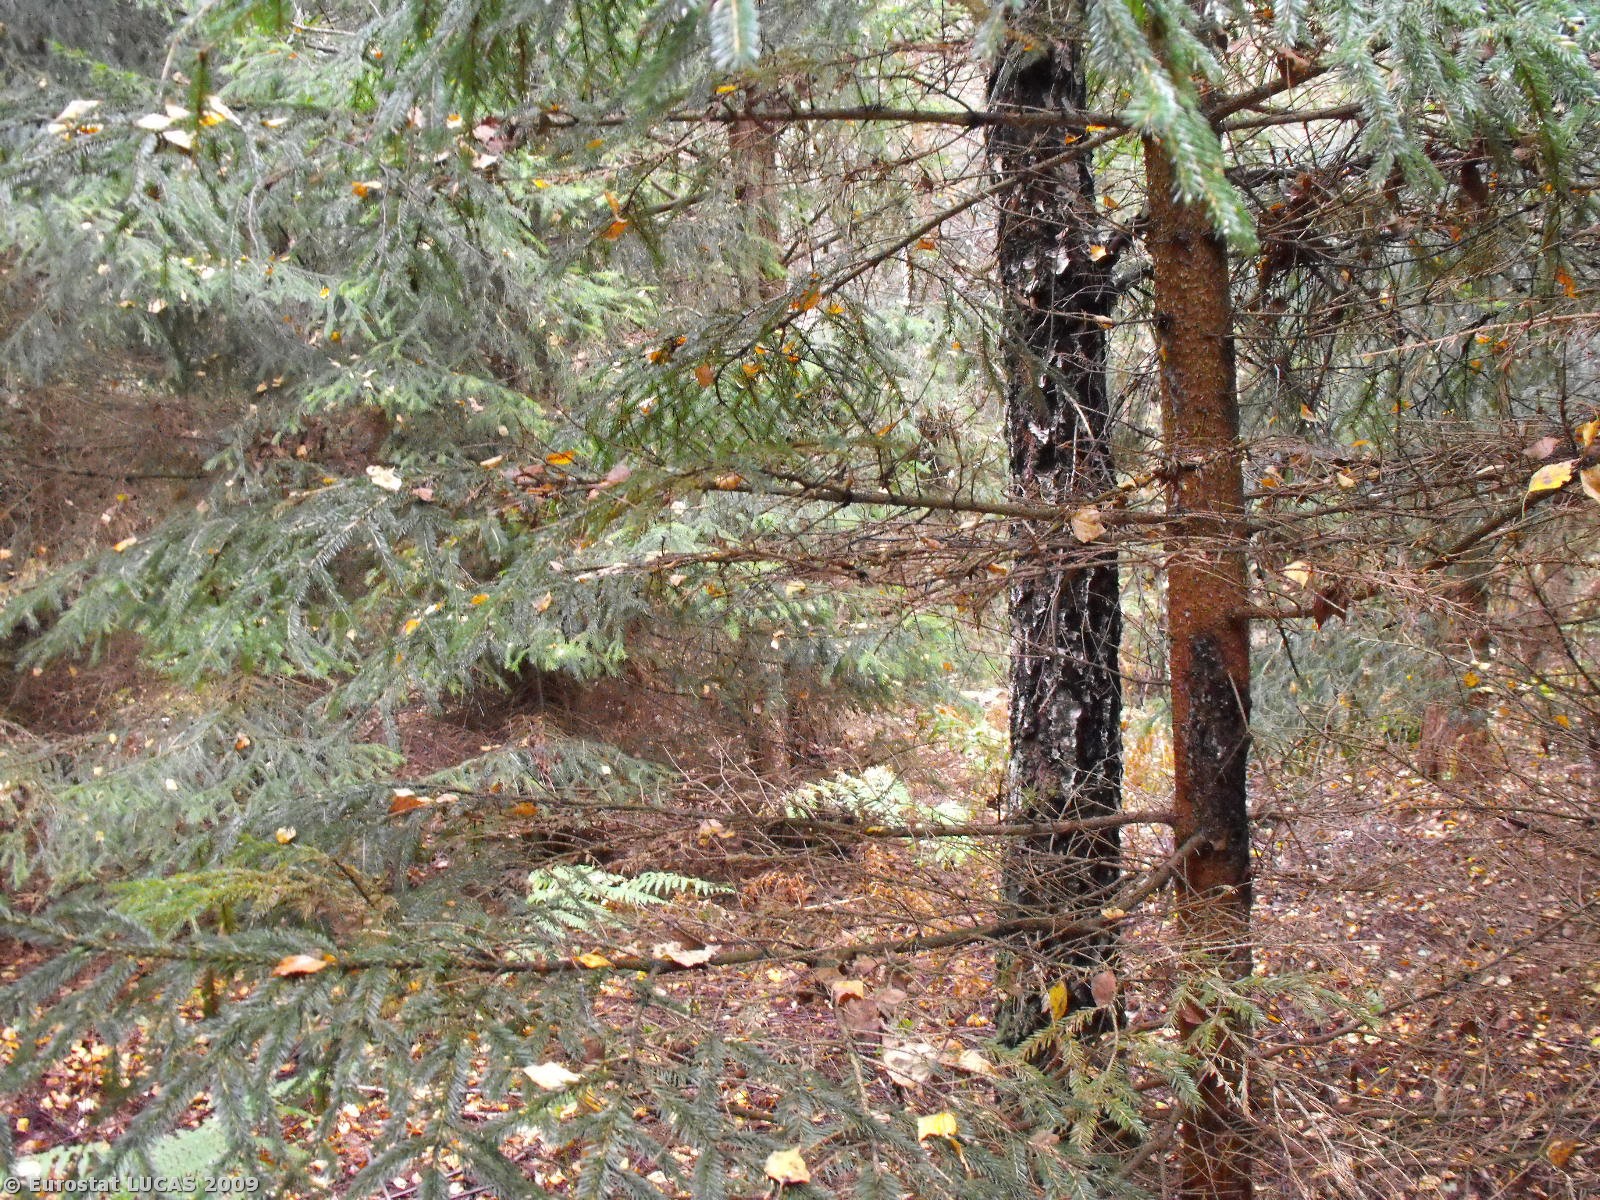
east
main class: Woodland
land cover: Coniferous woodland
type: hemiboreal forest and nemoral coniferous forest and mixed broadleaved-coniferous forest
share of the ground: > 75 %
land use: Forestry
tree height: > 5 m
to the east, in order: Coniferous woodland; Tracks; Coniferous woodland
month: September
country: PL
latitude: 53.1041
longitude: 16.4445
